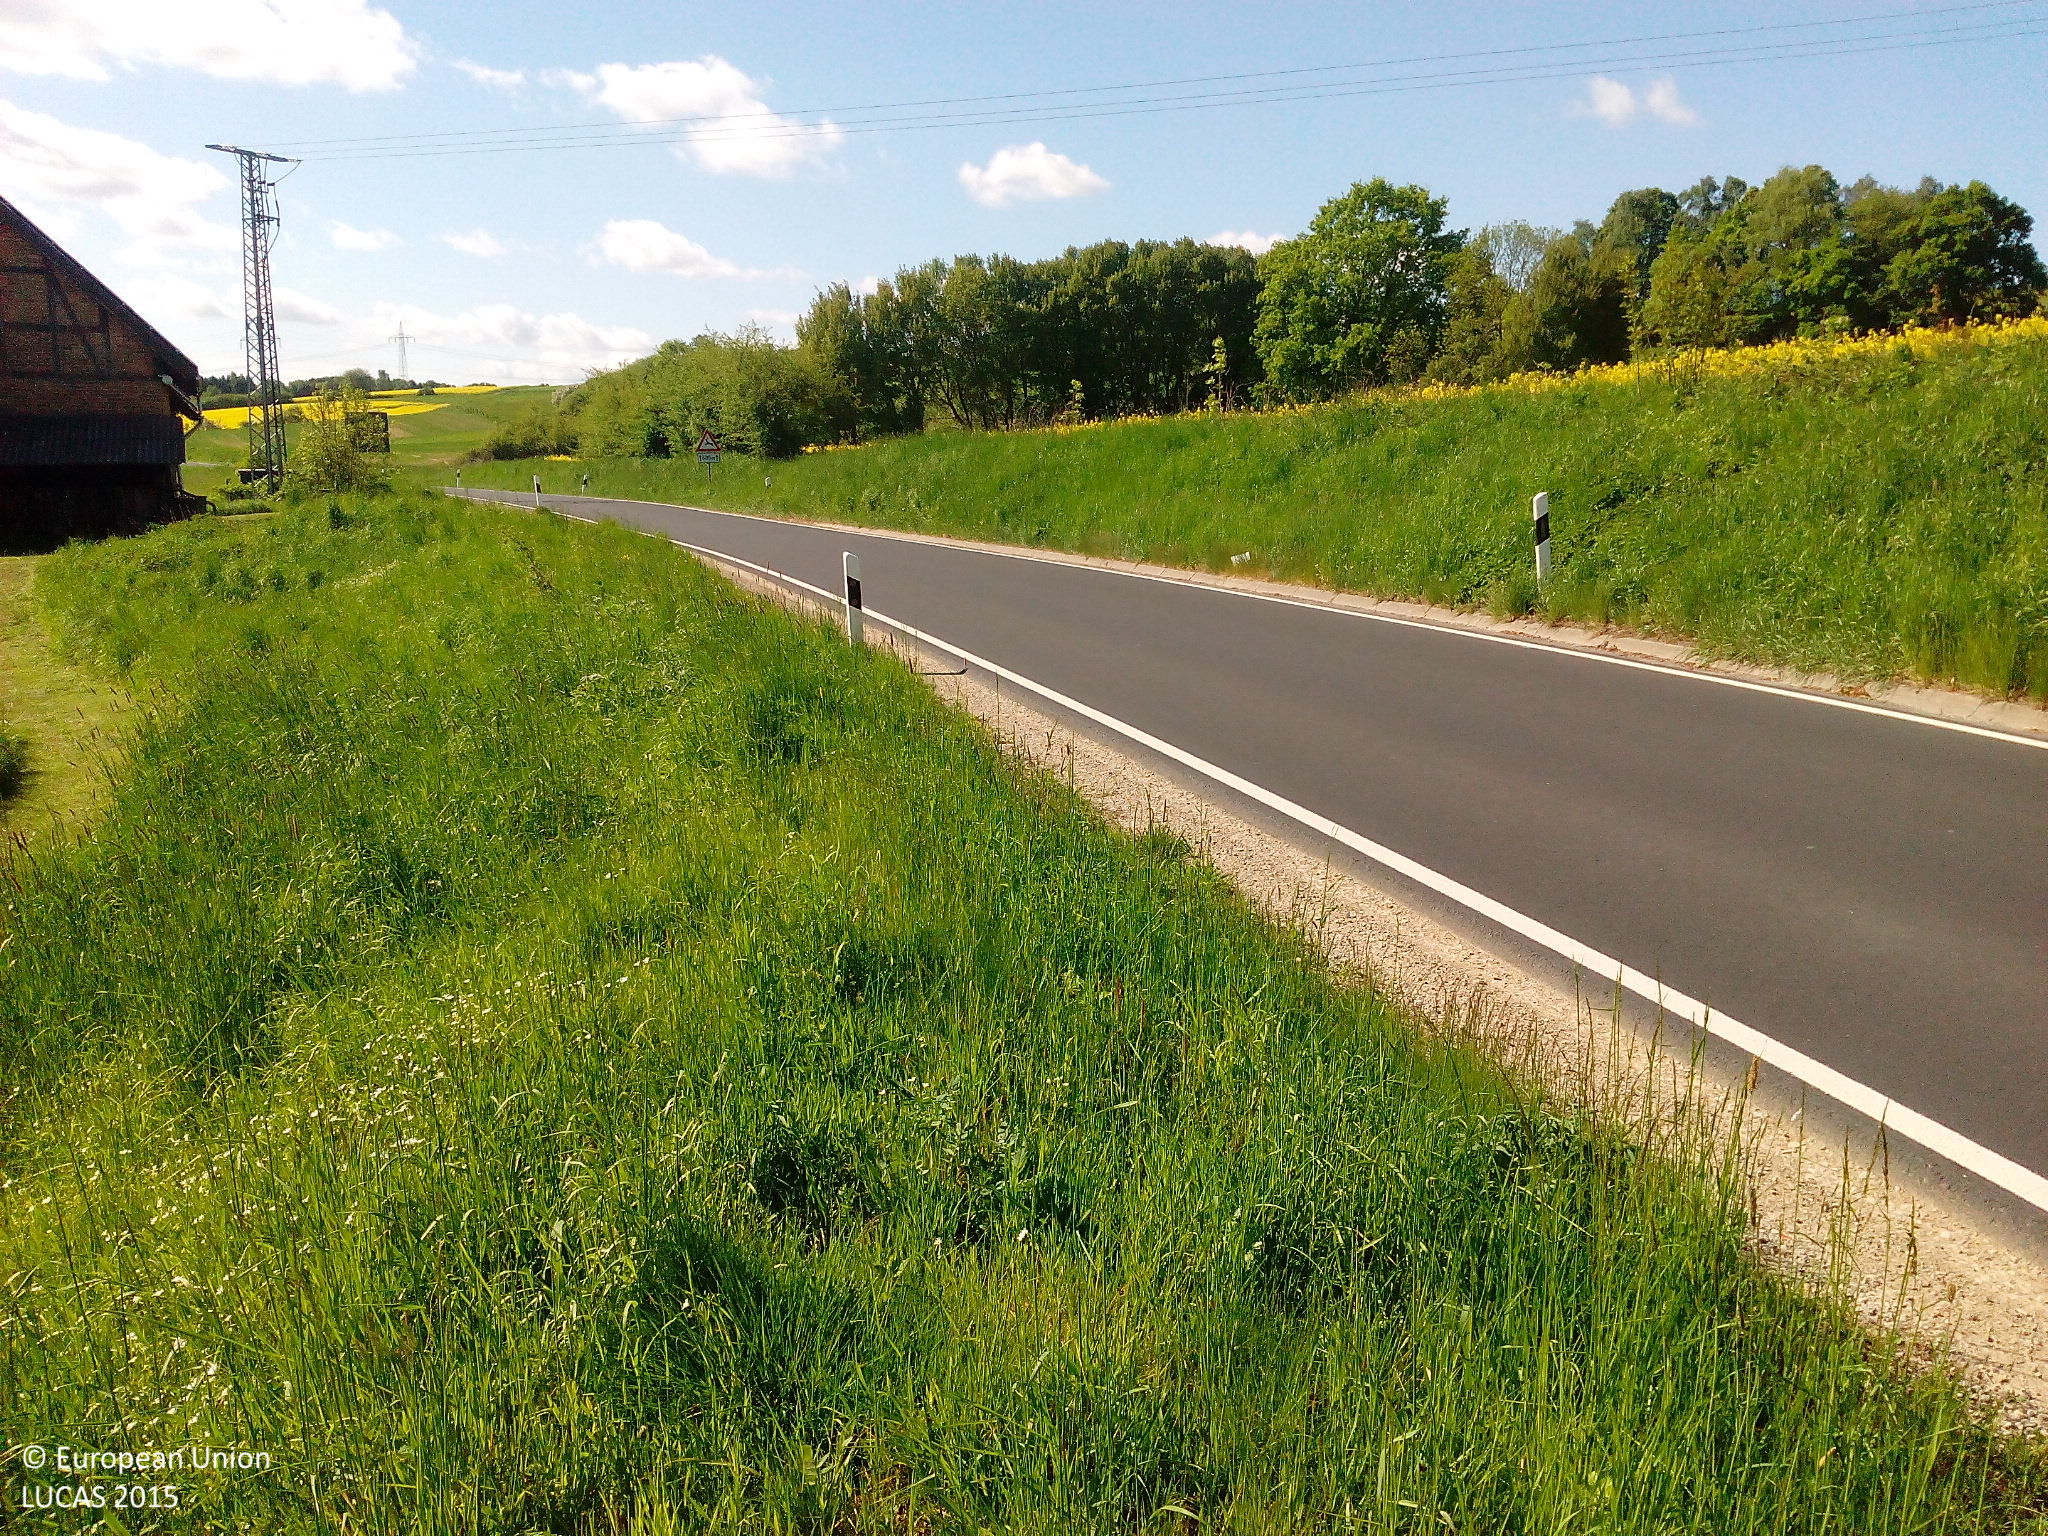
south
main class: Grassland
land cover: Grassland with sparse tree/shrub cover
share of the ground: > 75 %
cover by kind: herbaceous plants 85 %, shrubs 10 %, broadleaved forest trees 5 %
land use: Semi-natural and natural areas not in use
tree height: < 5 m
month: May
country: DE
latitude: 51.3522
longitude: 9.6124
